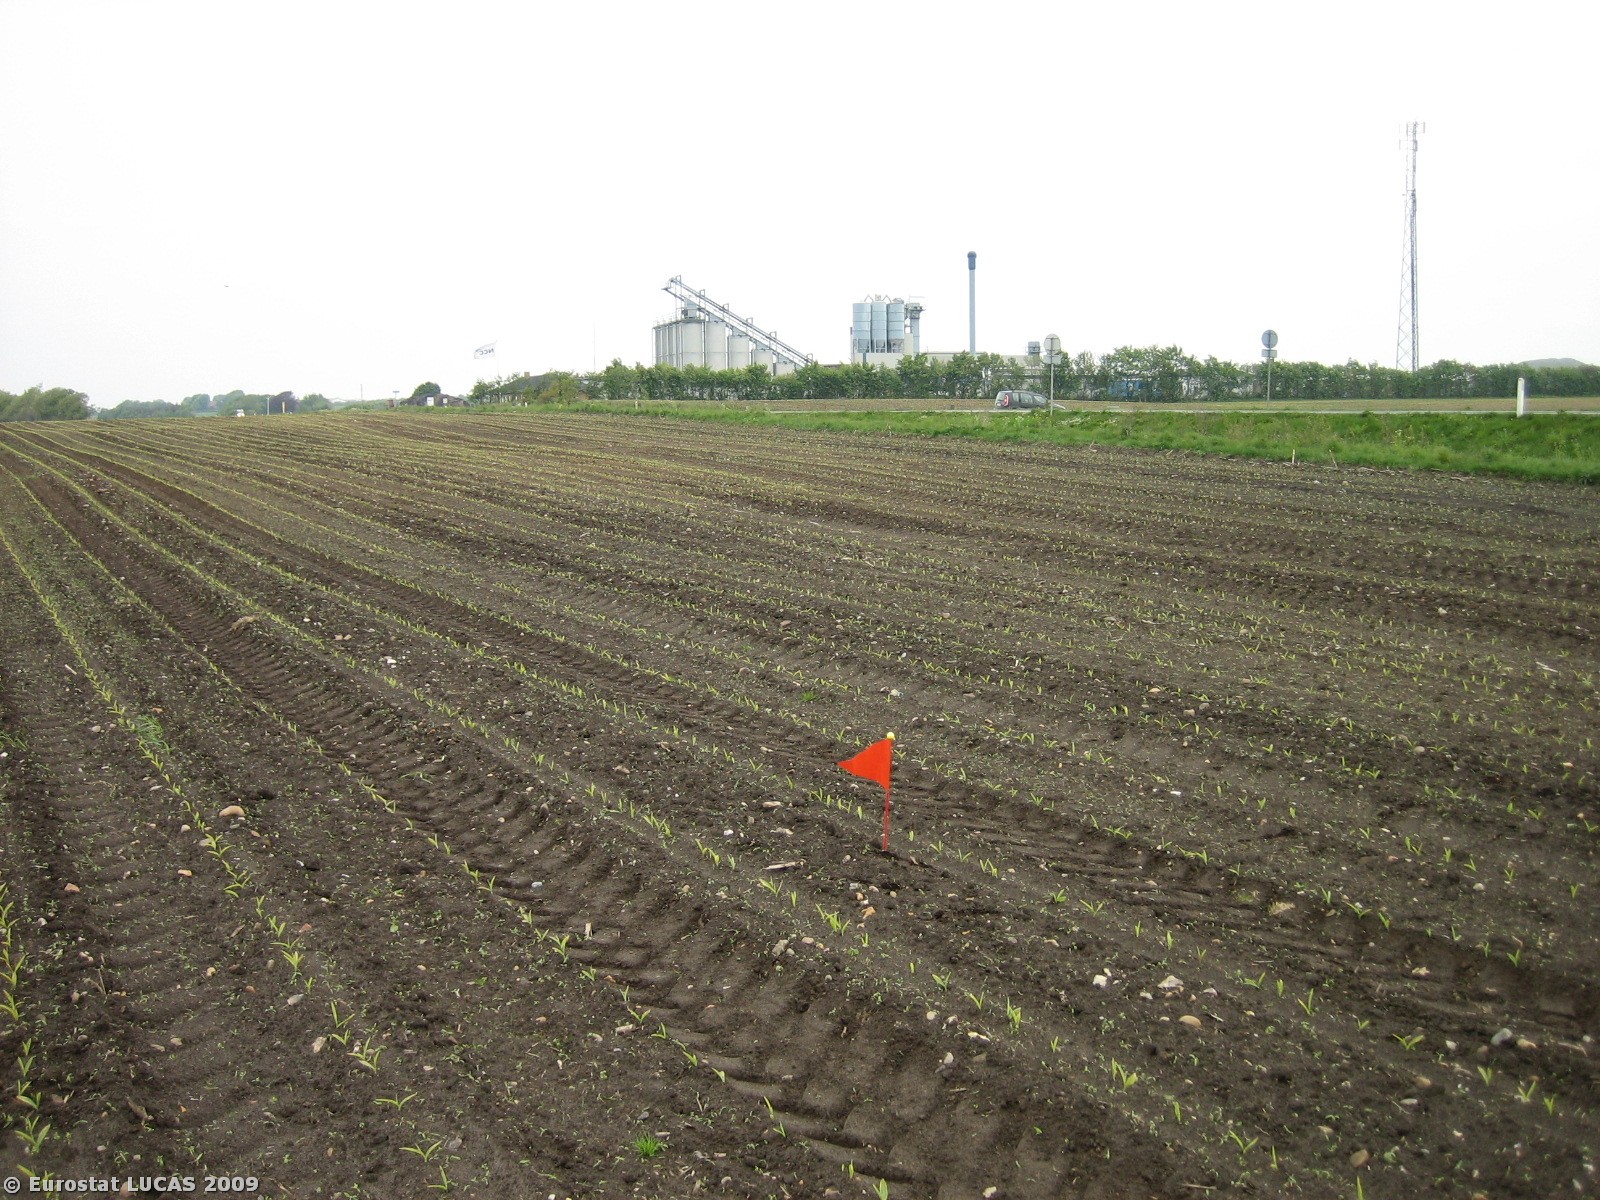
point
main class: Cropland
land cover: Maize
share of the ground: < 10 %
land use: Agriculture (excluding fallow land and kitchen gardens)
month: May
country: DK
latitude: 56.0892
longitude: 8.5069
